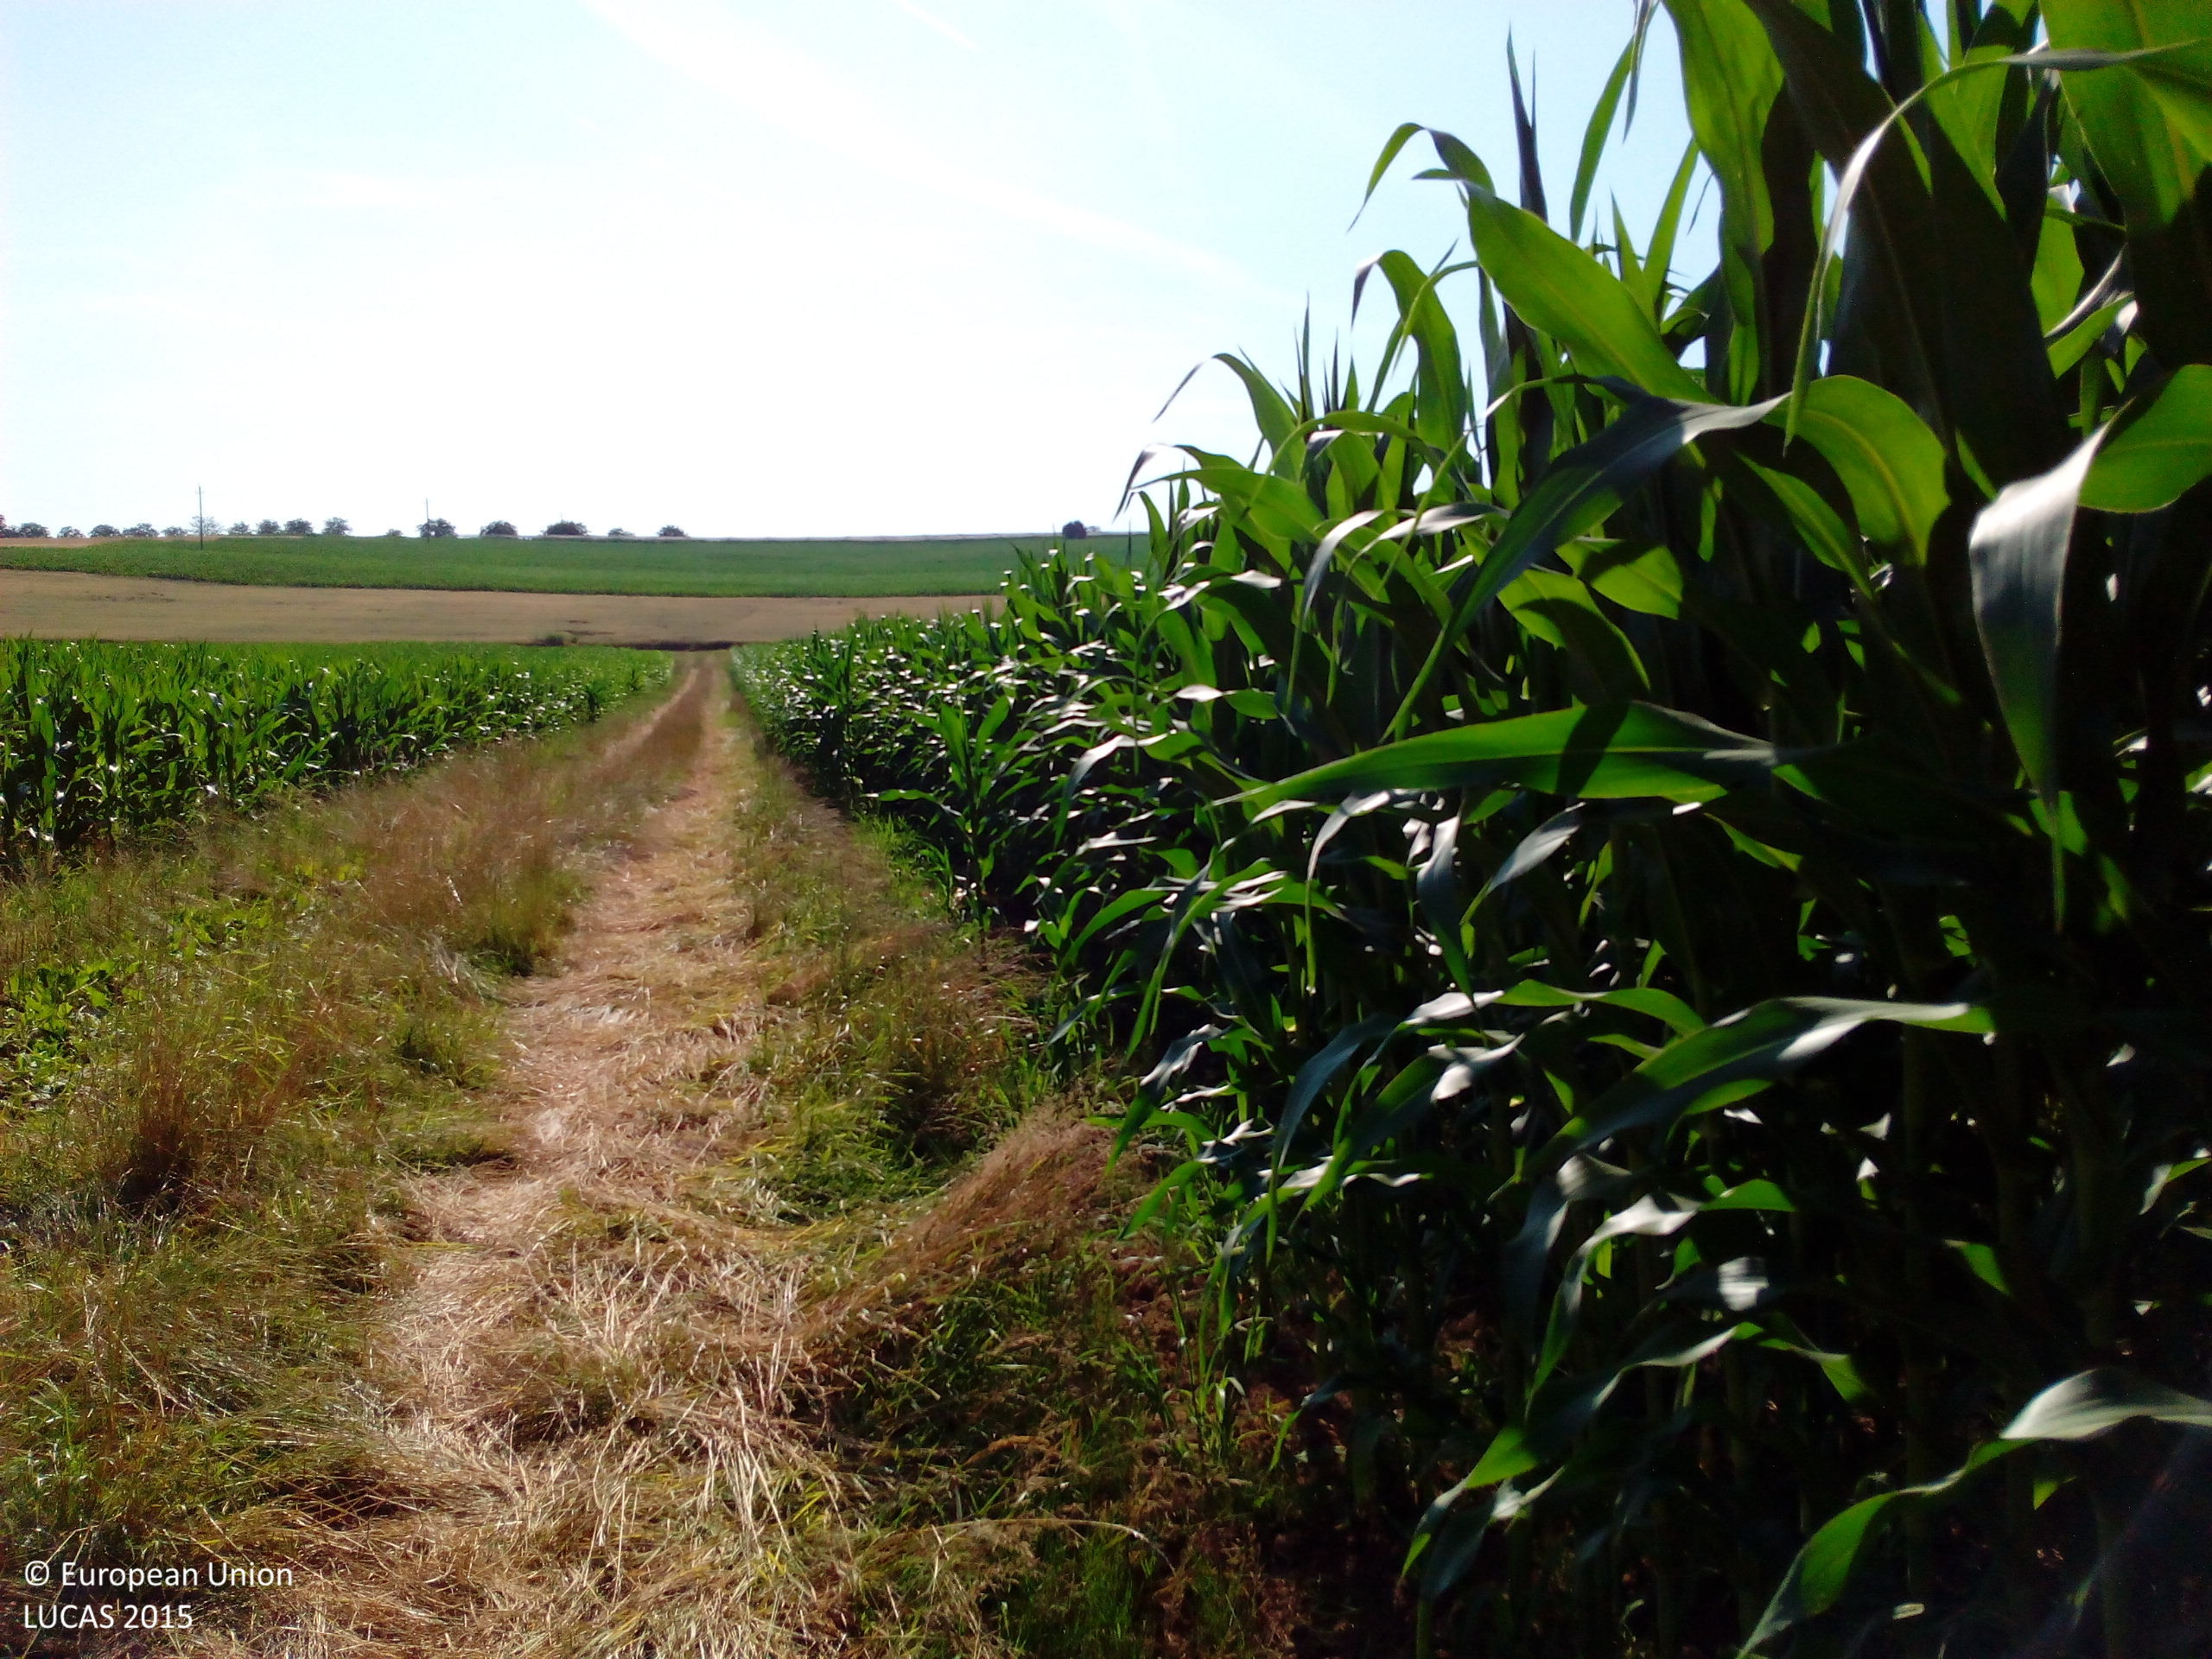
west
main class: Cropland
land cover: Maize
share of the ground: > 75 %
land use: Agriculture (excluding fallow land and kitchen gardens)
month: July
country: DE
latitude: 47.6763
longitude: 7.6439
